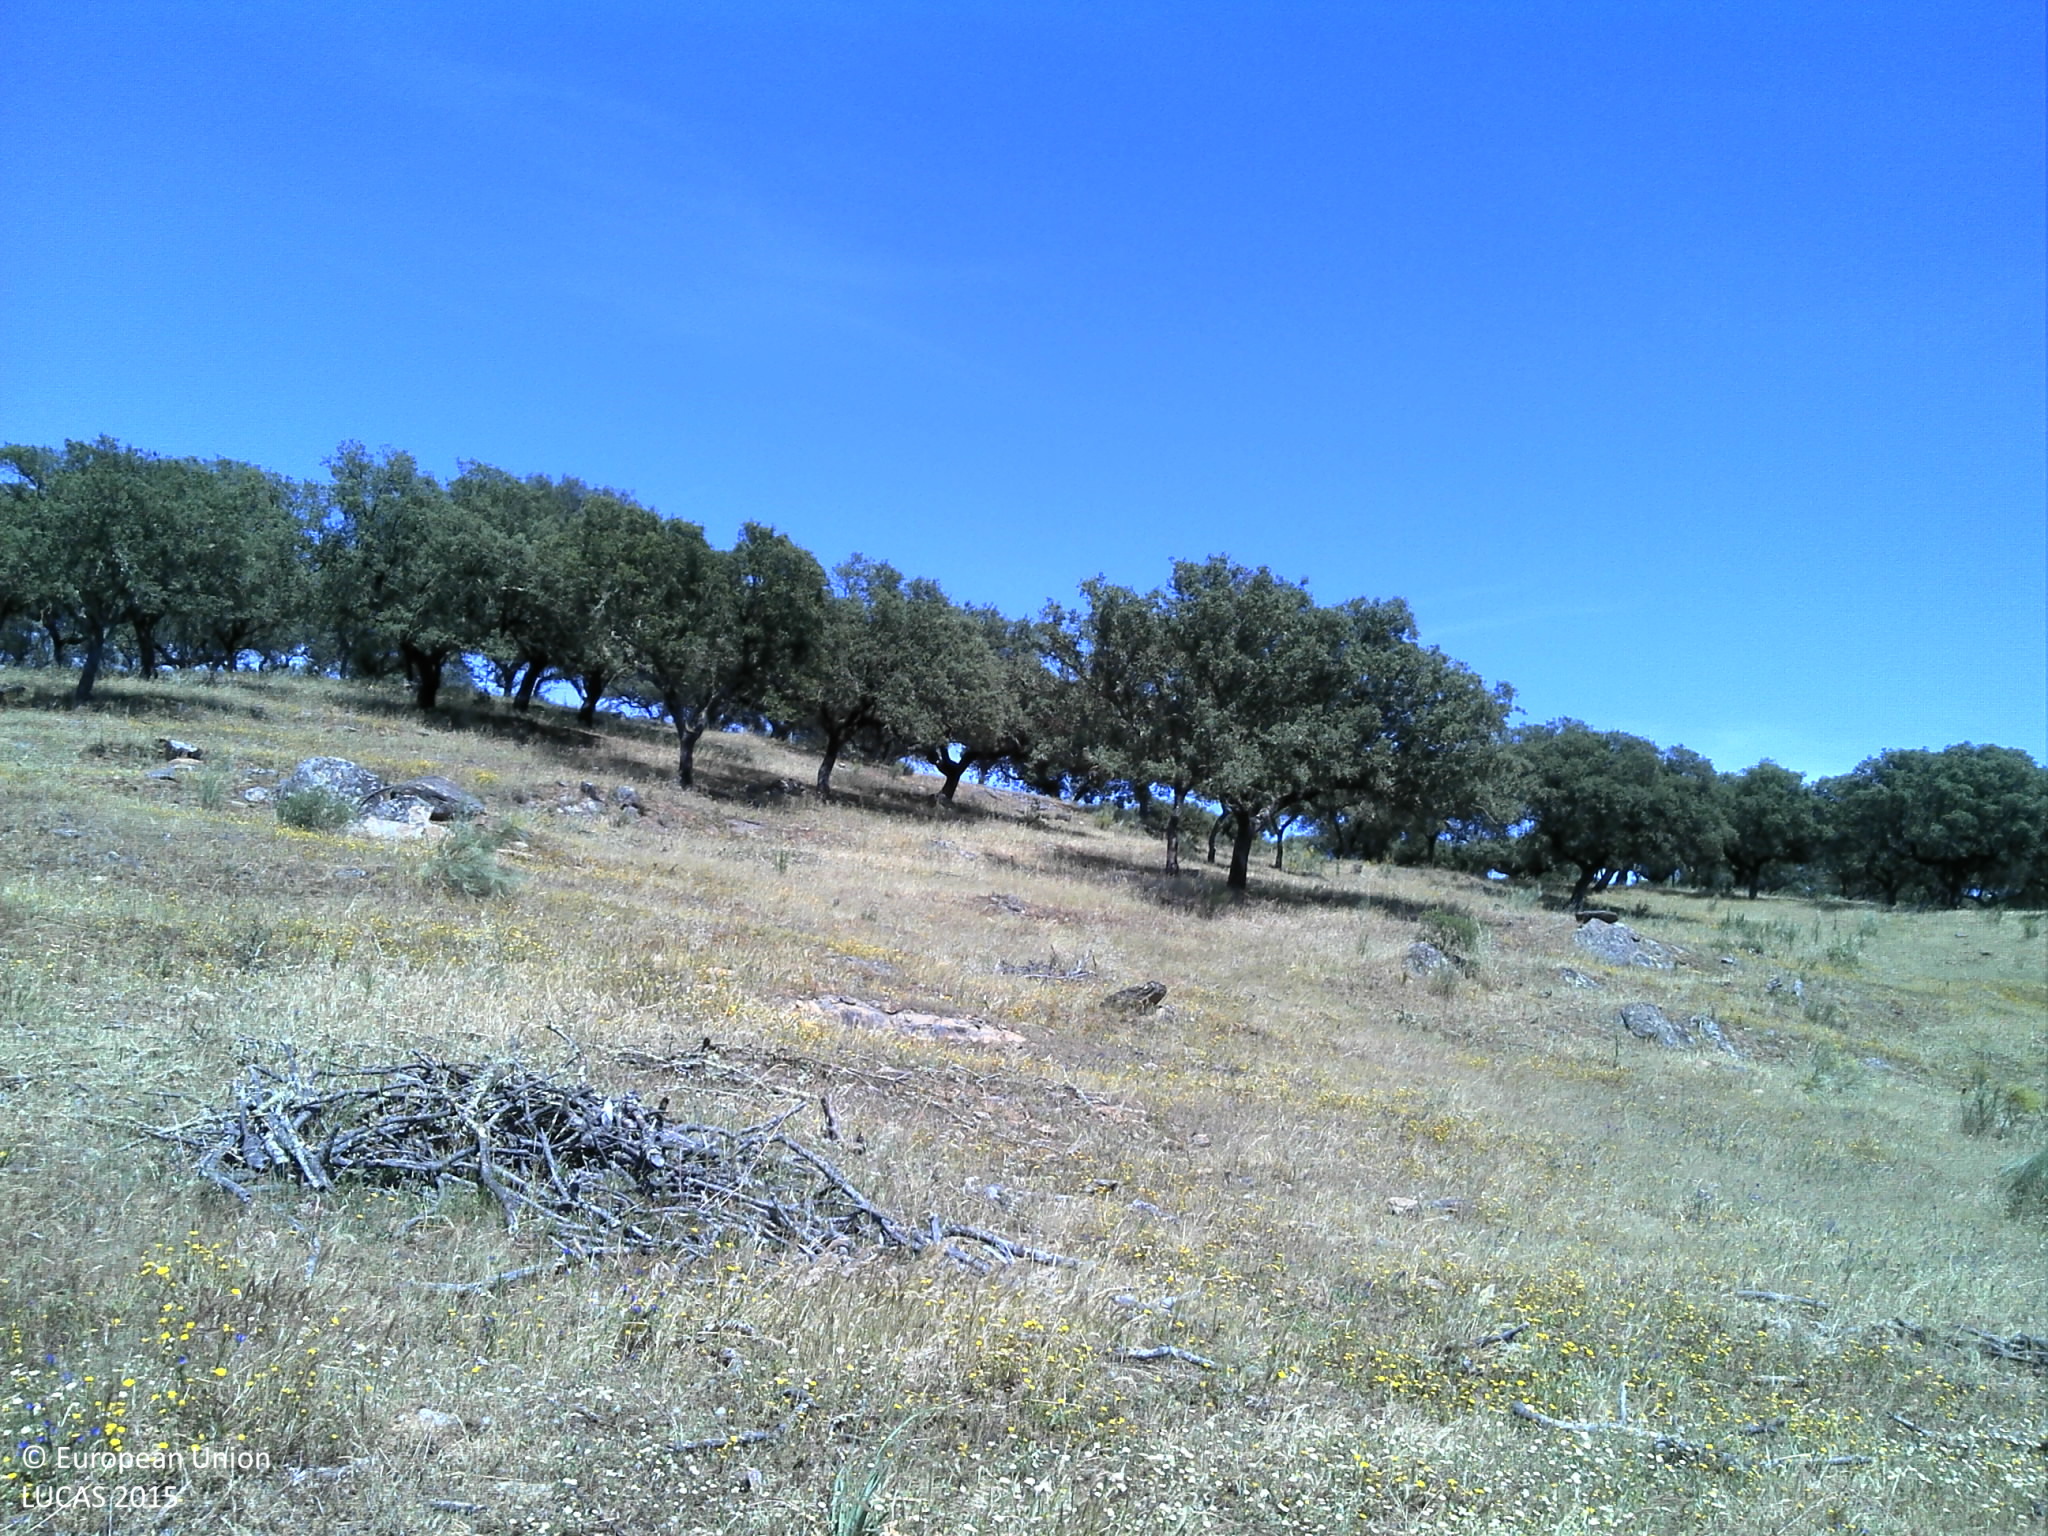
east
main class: Grassland
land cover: Grassland with sparse tree/shrub cover
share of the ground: 10 - 25 %
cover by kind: unconsolidated bare surface 70 %, herbaceous plants 25 %, broadleaved forest trees 5 %
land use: Agriculture (excluding fallow land and kitchen gardens)
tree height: > 5 m
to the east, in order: Grassland with sparse tree/shrub cover; Grassland without tree/shrub cover; Broadleaved woodland
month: May
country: PT
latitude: 39.2881
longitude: -7.6103
